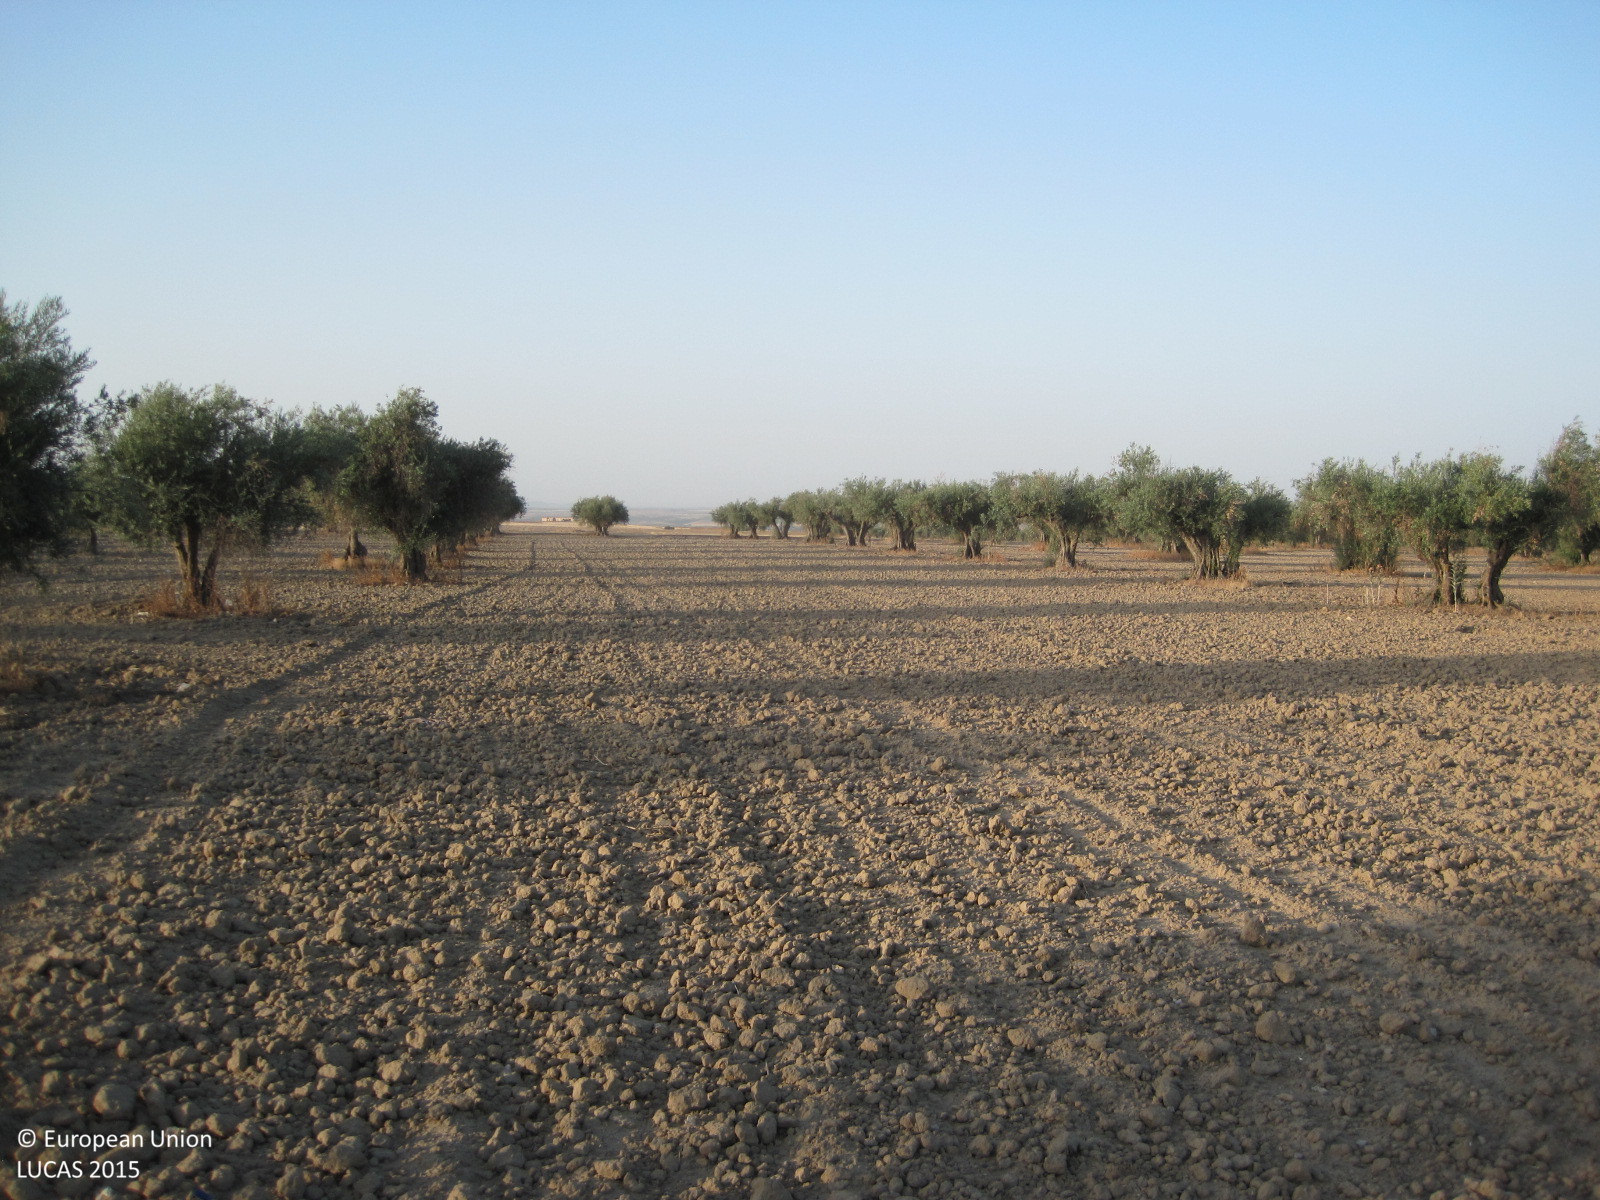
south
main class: Cropland
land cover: Olive groves
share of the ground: 50 - 75 %
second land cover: Other bare soil
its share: > 75 %
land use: Agriculture (excluding fallow land and kitchen gardens)
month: July
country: ES
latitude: 39.9988
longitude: -3.8198
